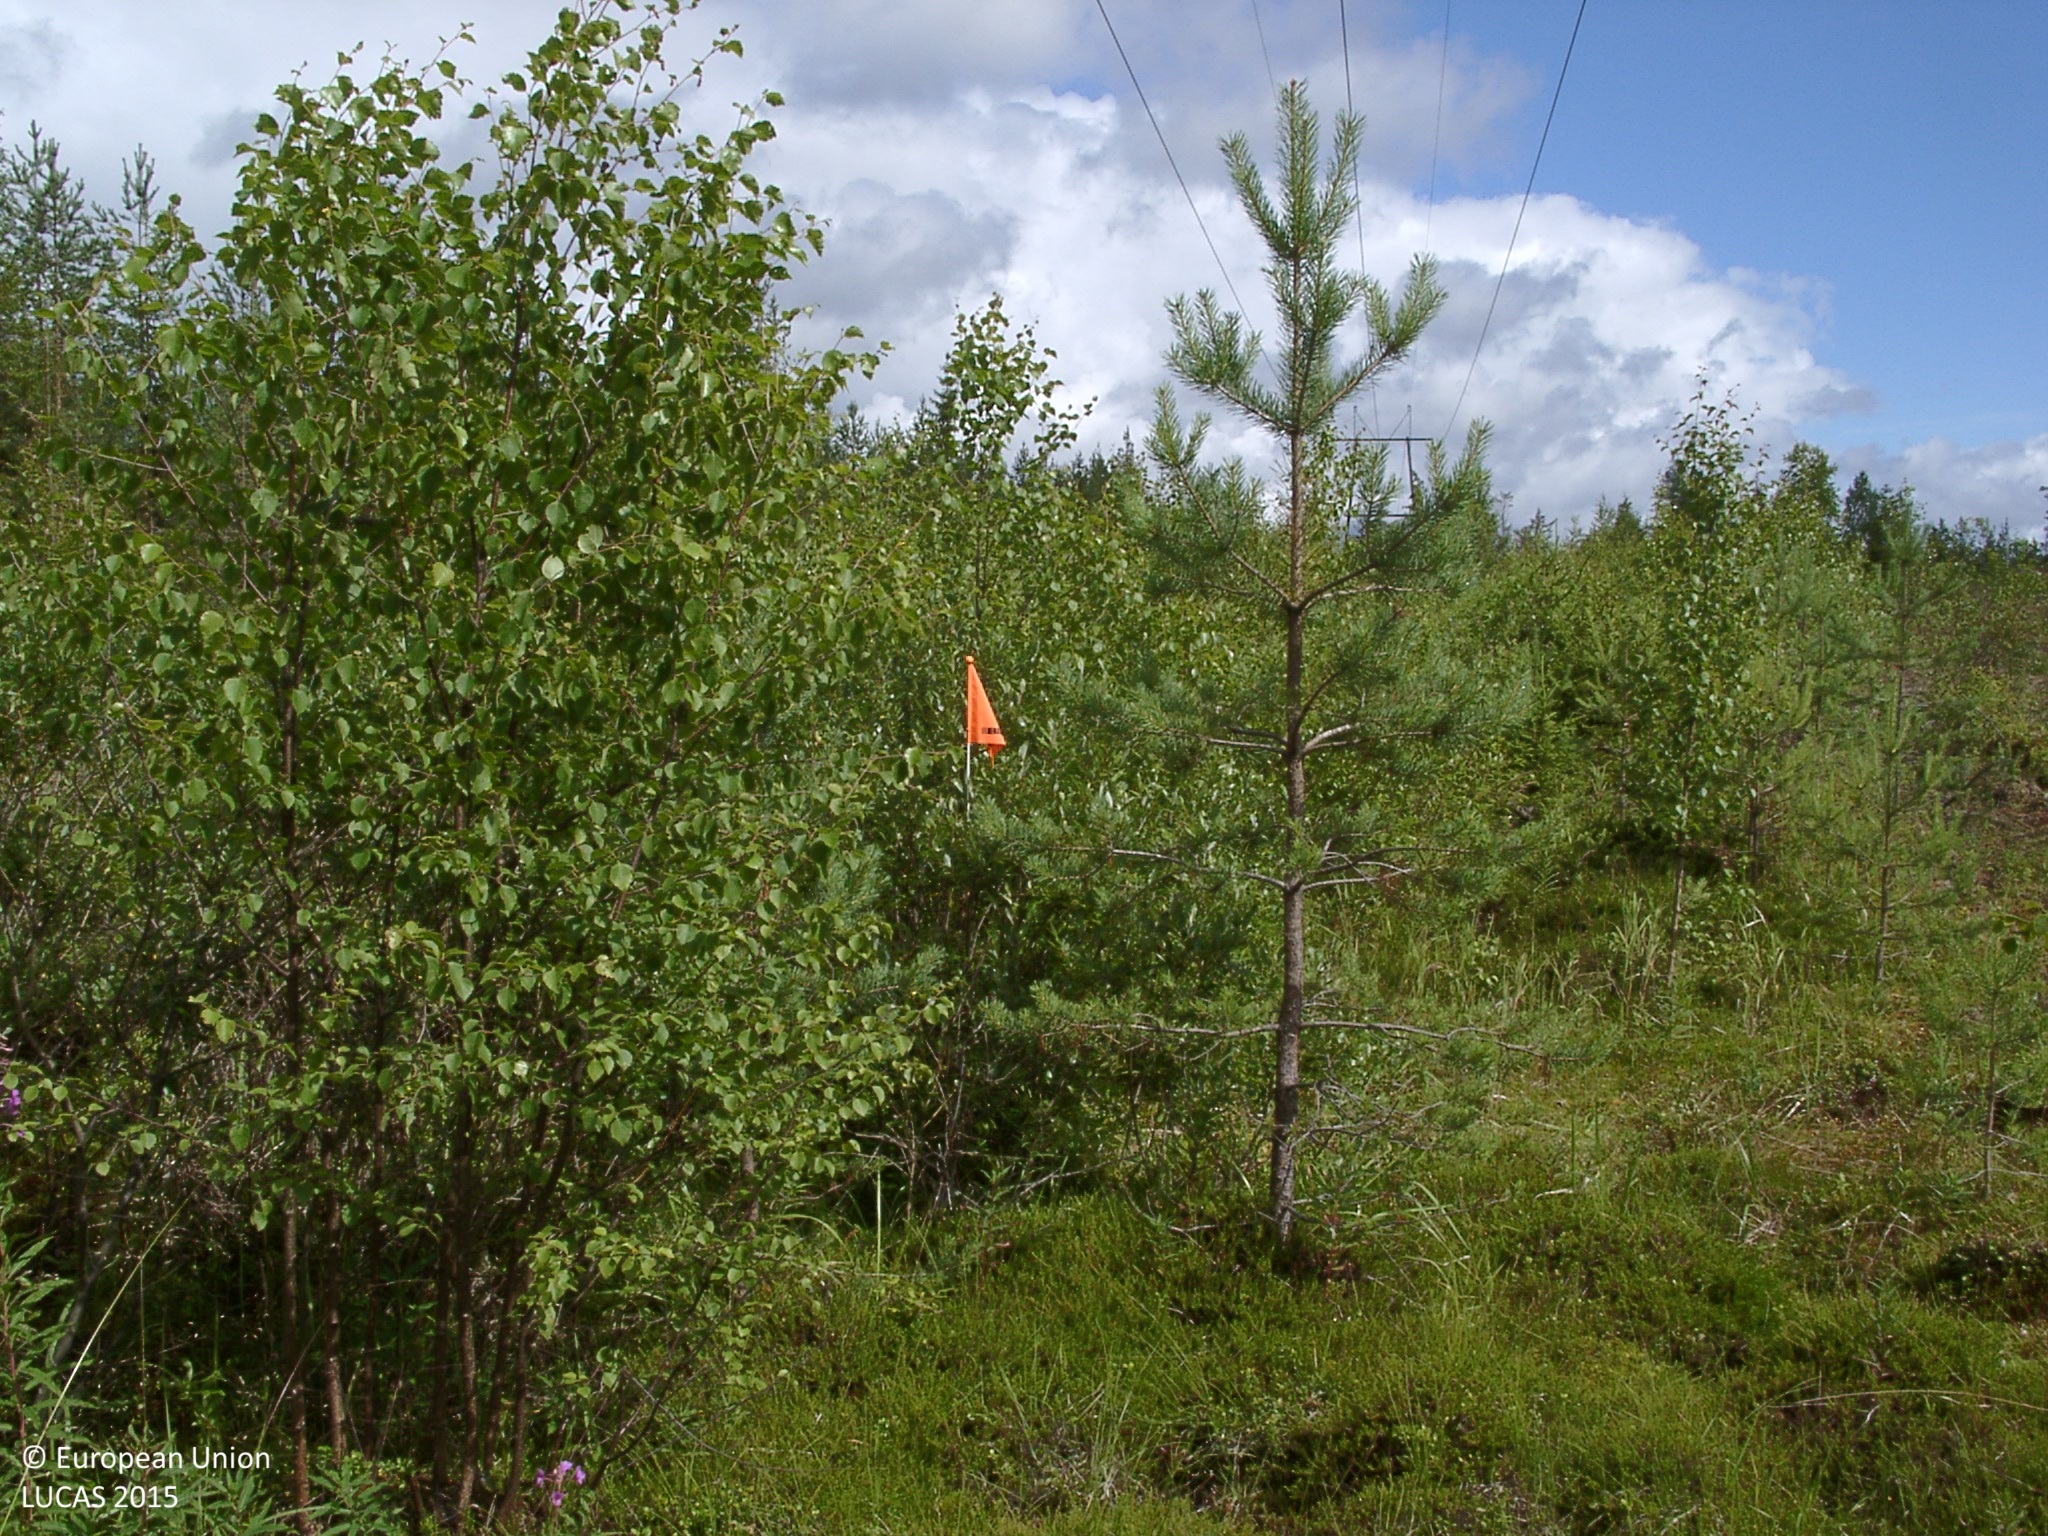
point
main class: Artificial land
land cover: Other artificial areas
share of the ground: > 75 %
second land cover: Broadleaved woodland
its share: 50 - 75 %
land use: Electricity, gas and thermal power distribution
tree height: < 5 m
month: July
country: FI
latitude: 62.2768
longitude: 25.1942
